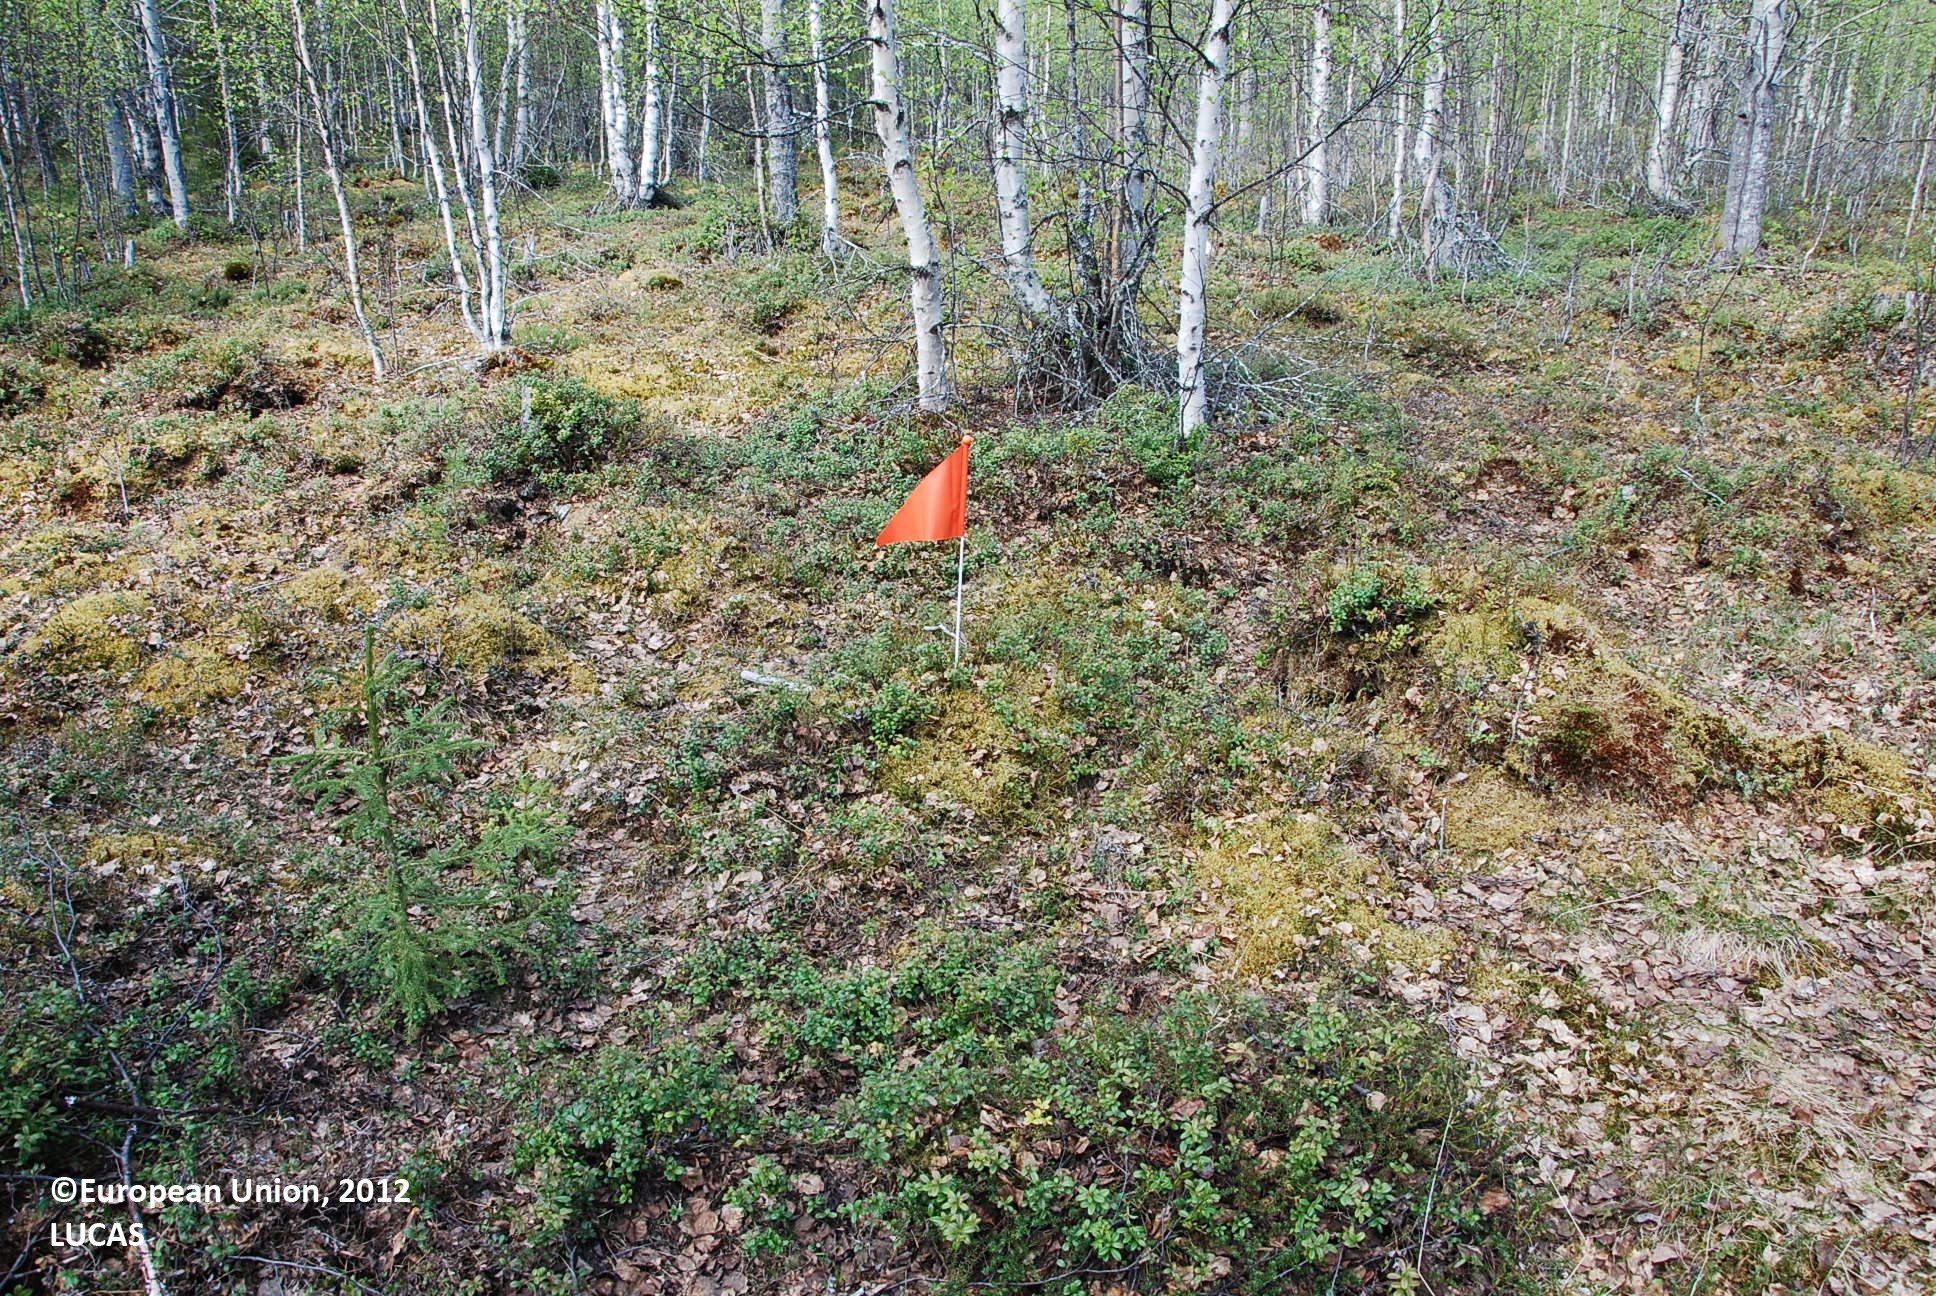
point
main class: Woodland
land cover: Broadleaved woodland
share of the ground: 50 - 75 %
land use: Forestry
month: June
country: FI
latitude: 66.9529
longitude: 28.2357
